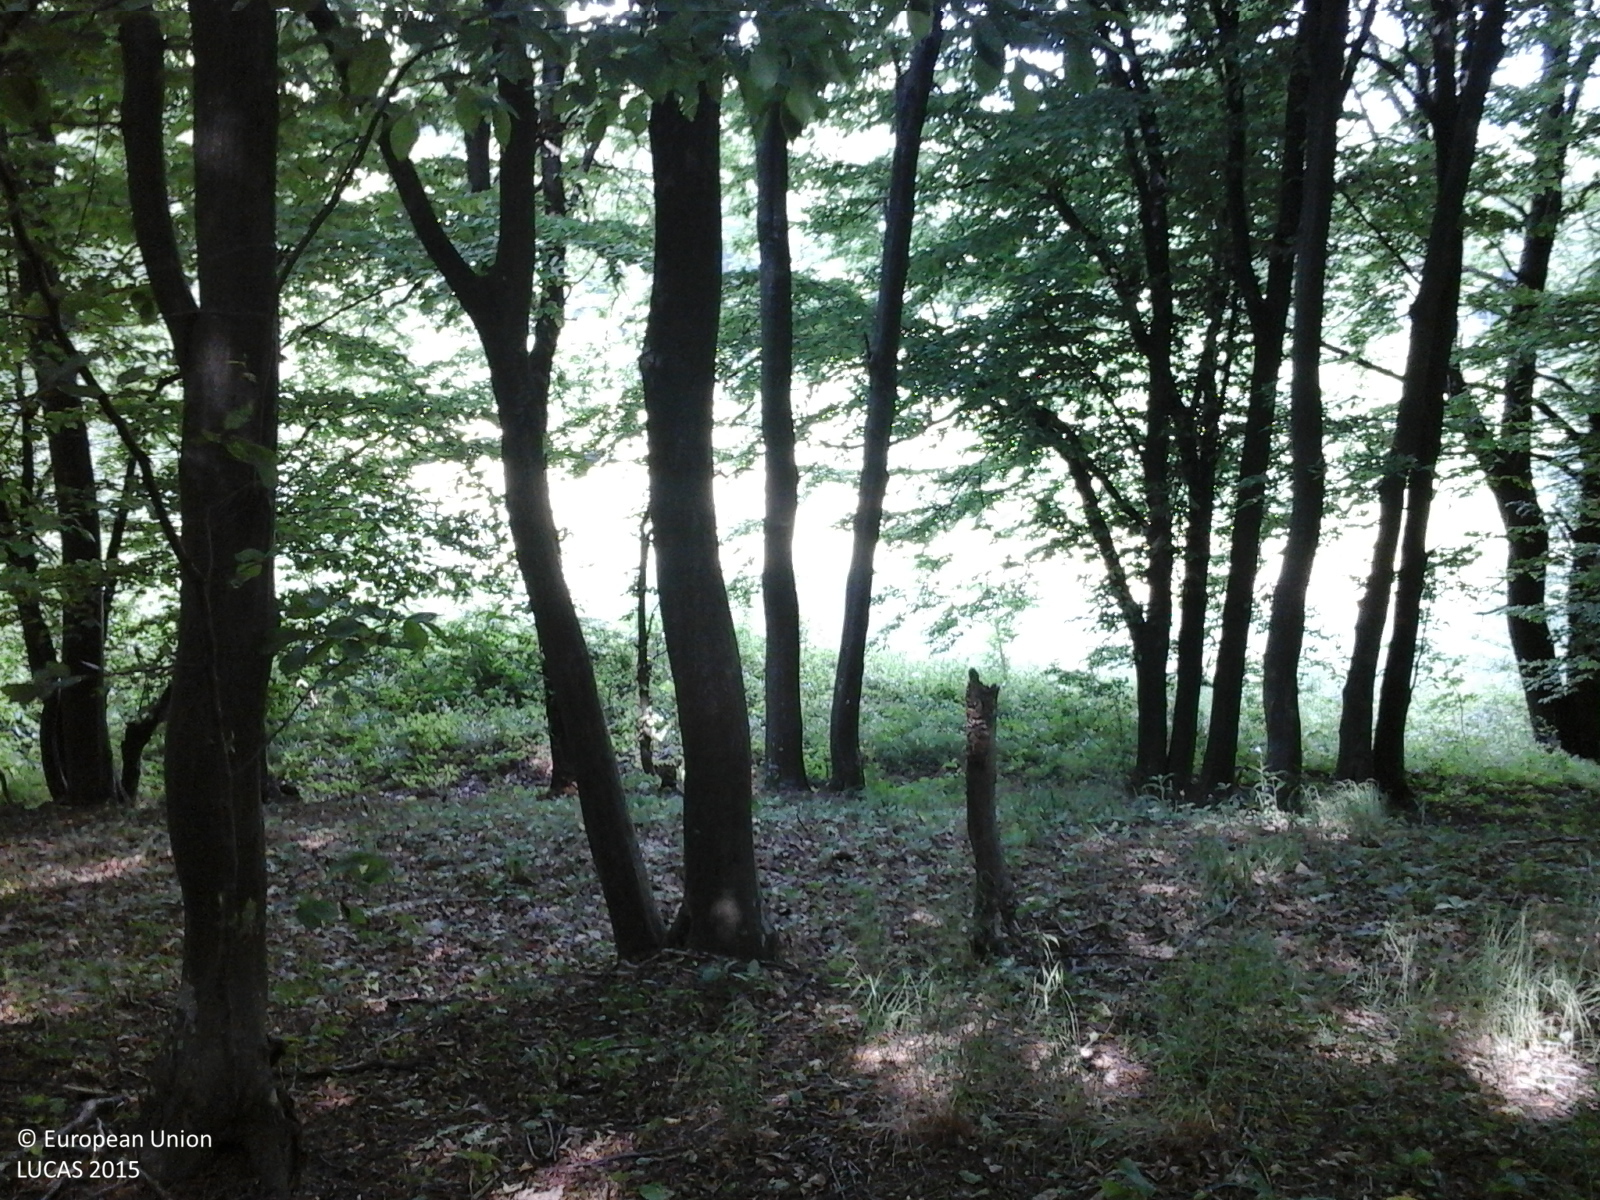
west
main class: Woodland
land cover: Broadleaved woodland
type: beech forest
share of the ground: > 75 %
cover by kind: broadleaved forest trees 100 %
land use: Forestry
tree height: > 5 m
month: June
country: RO
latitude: 47.4030
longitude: 26.7789
